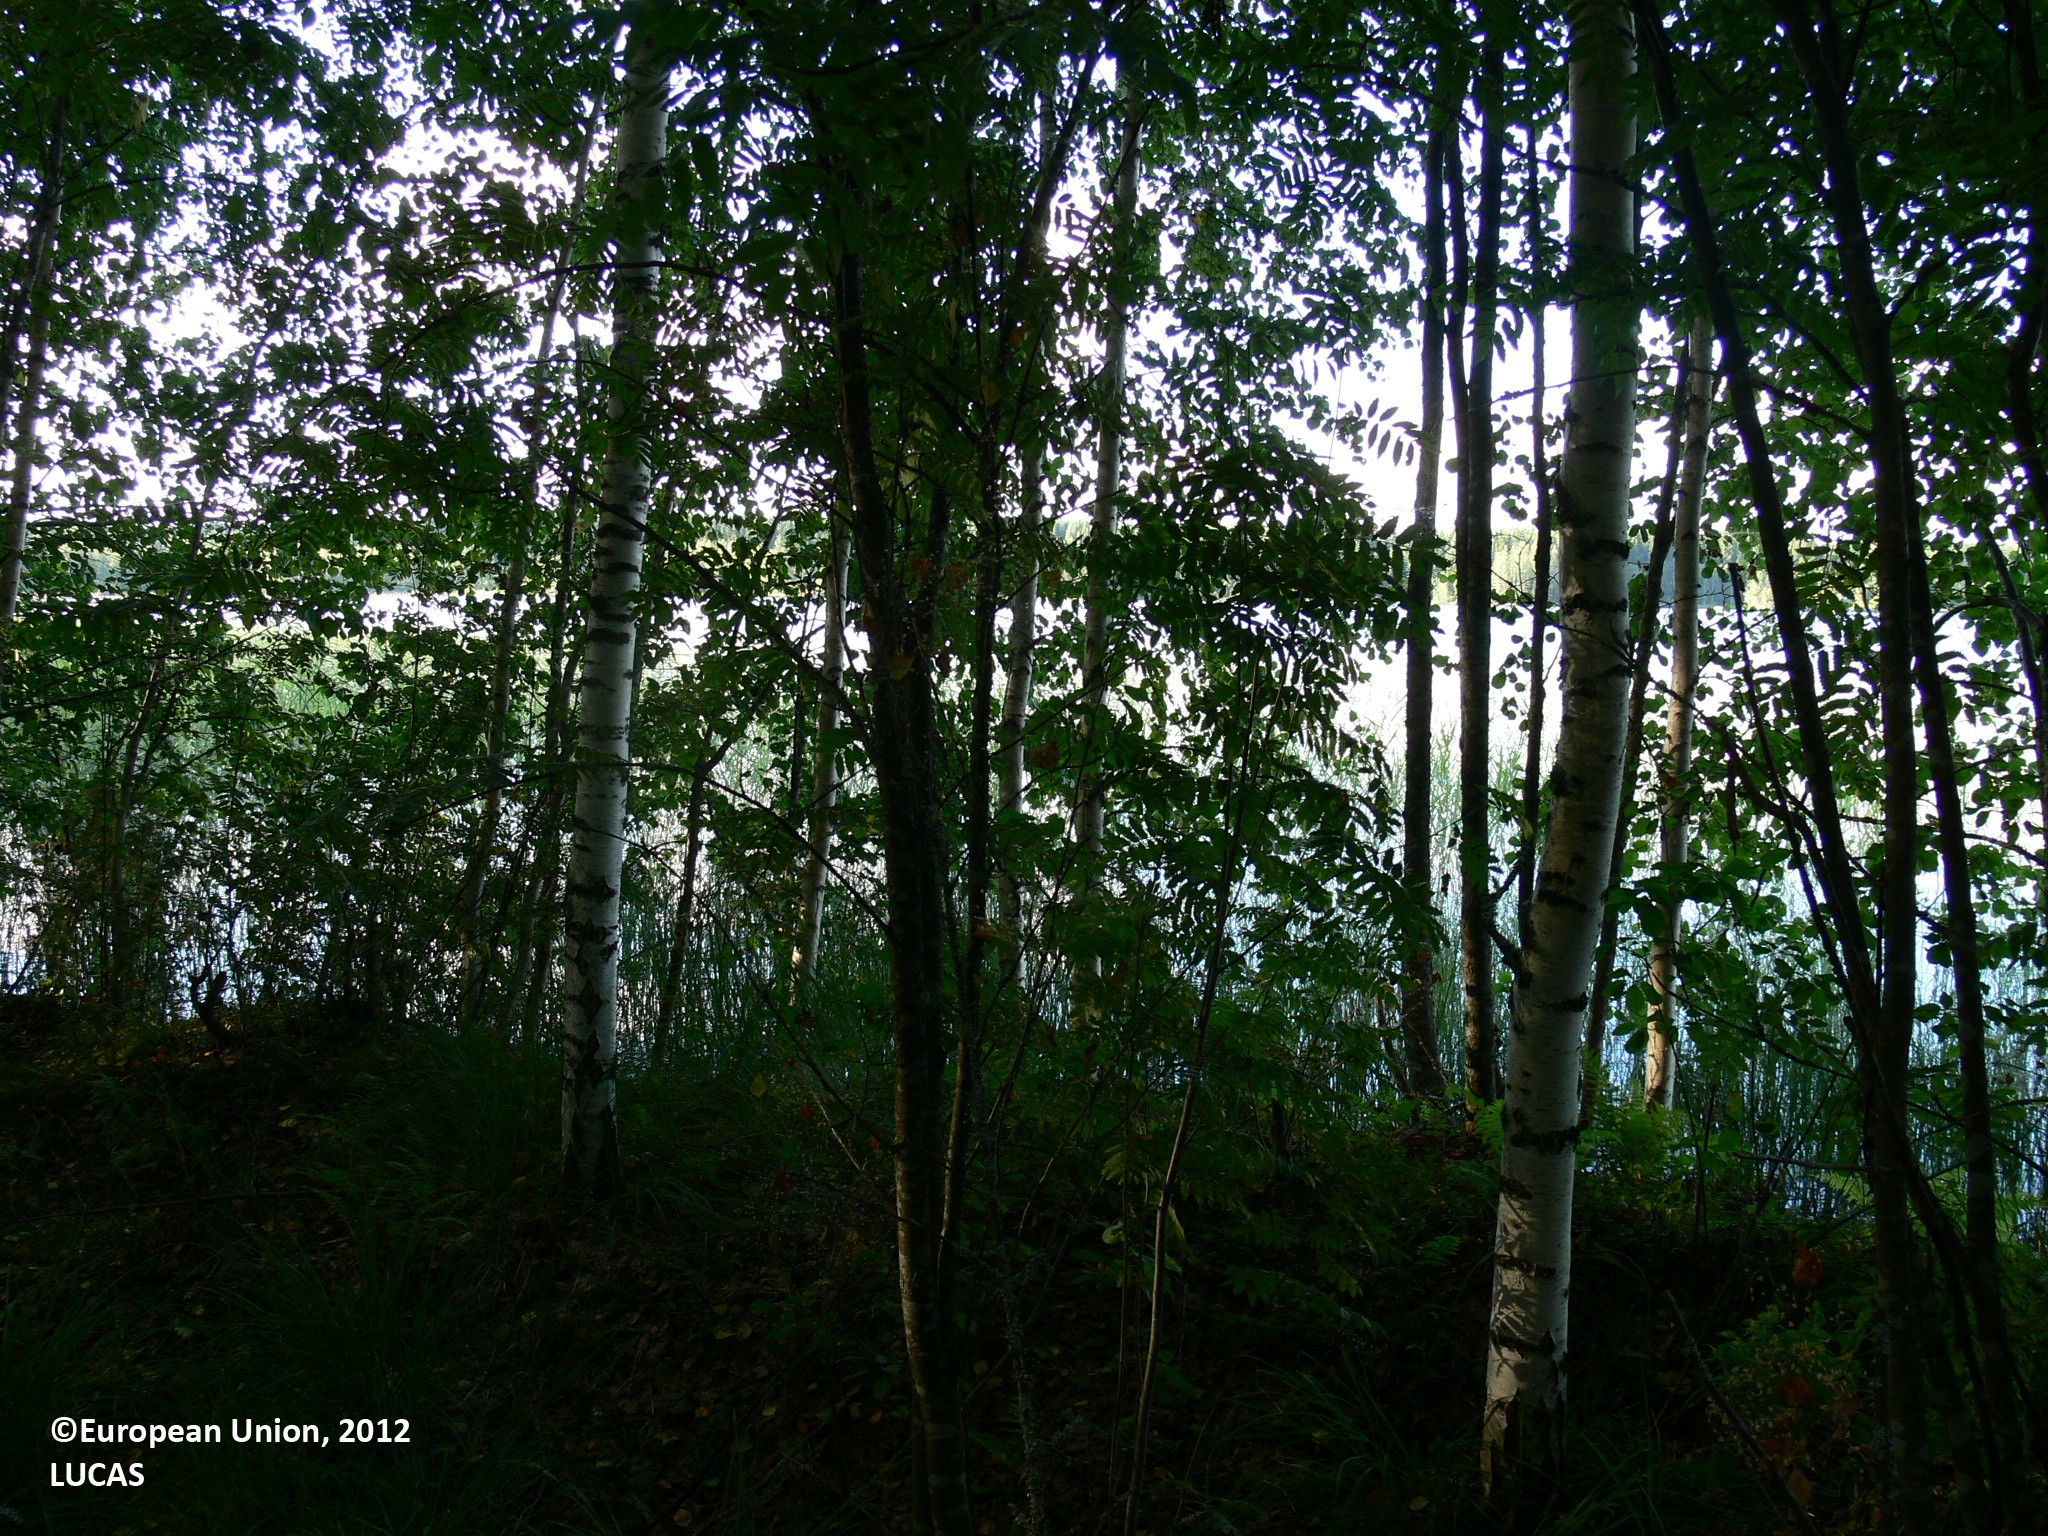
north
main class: Woodland
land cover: Broadleaved woodland
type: boreal forest
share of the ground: > 75 %
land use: Forestry
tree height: > 5 m
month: August
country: FI
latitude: 61.9926
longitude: 29.1884
